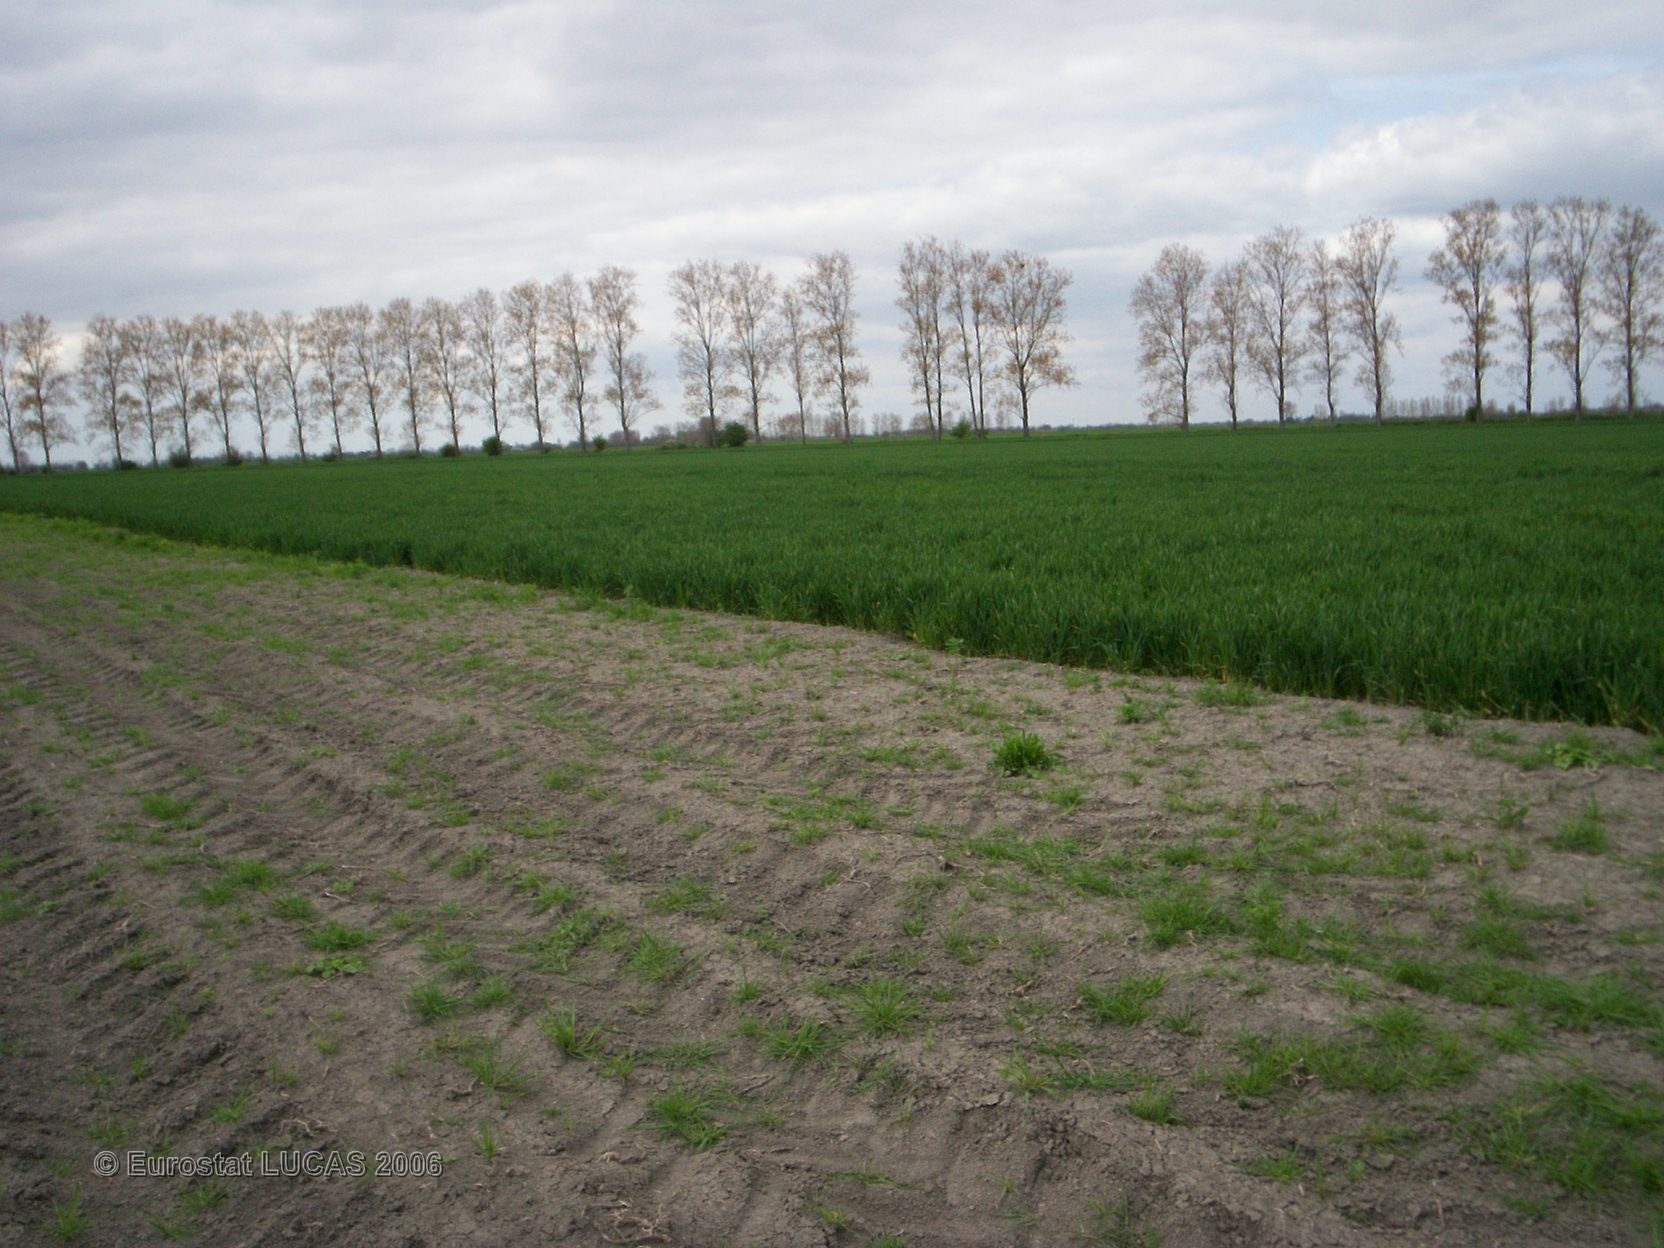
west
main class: Grassland
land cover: Grassland without tree/shrub cover
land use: Fallow land
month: April
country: FR
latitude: 46.3496
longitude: -0.9590
